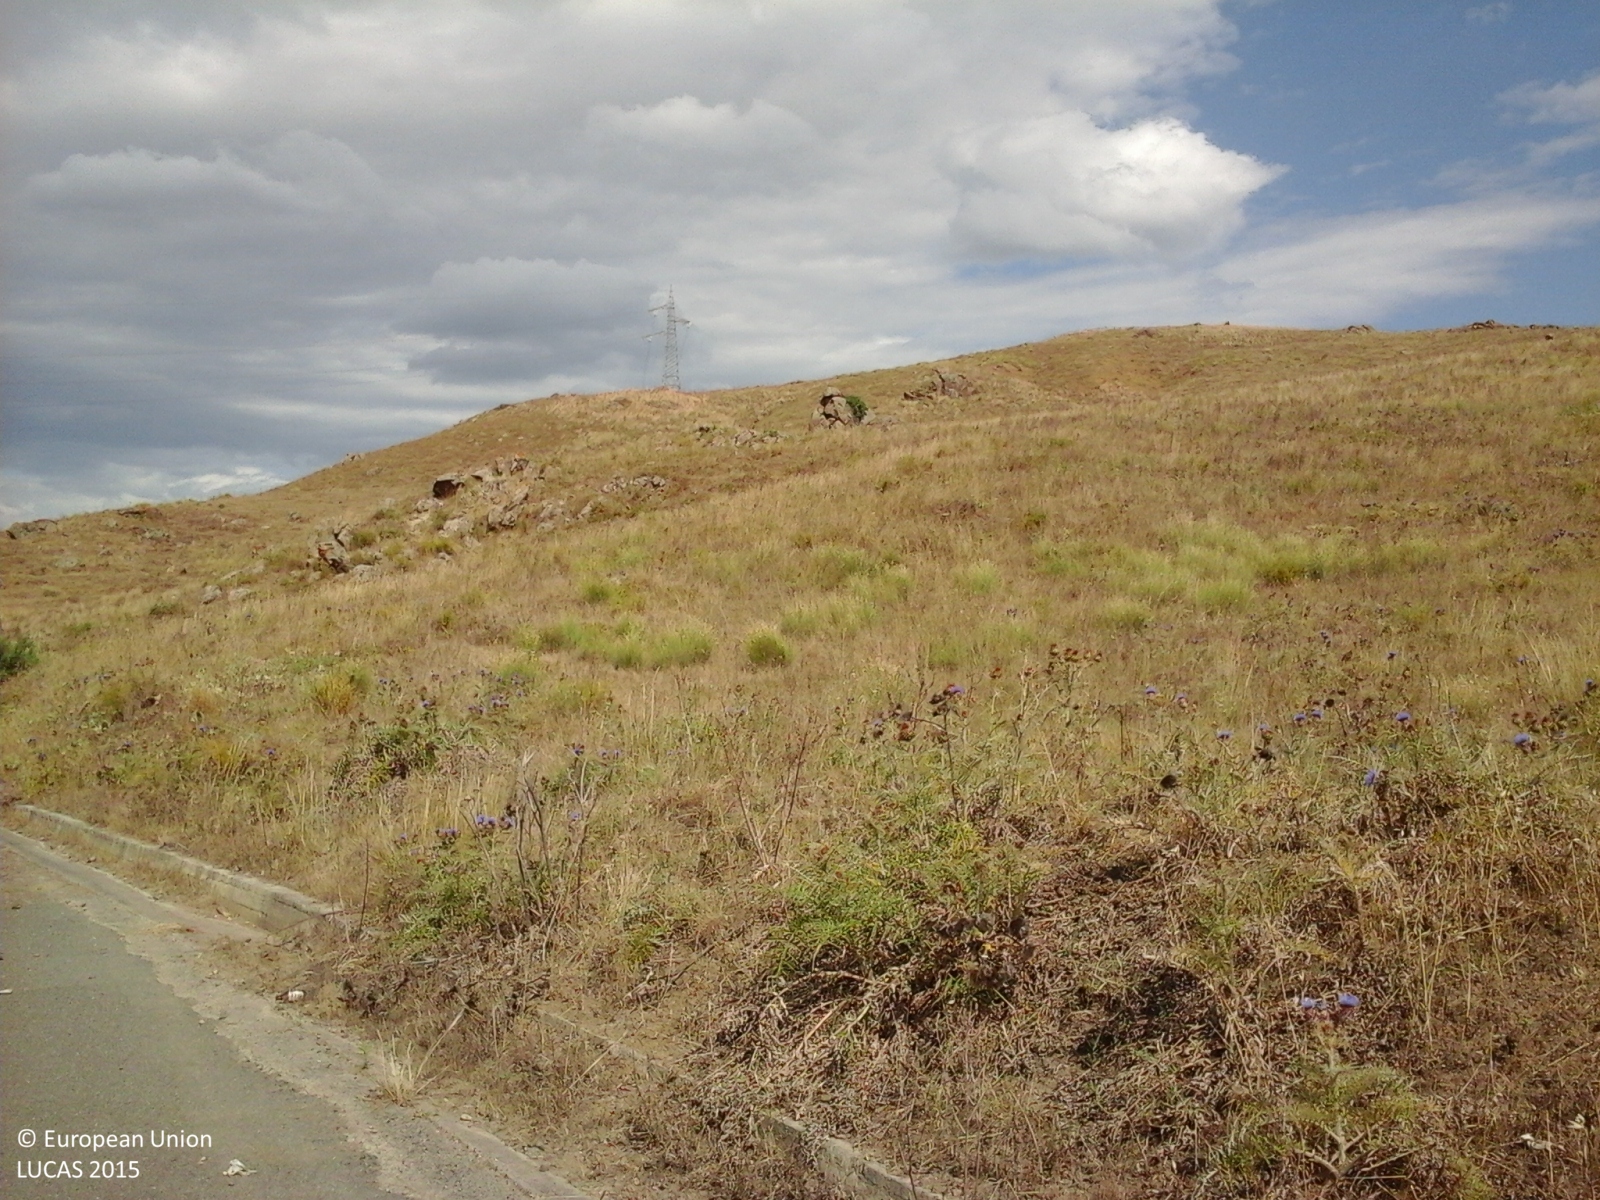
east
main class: Grassland
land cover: Grassland without tree/shrub cover
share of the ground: > 75 %
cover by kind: herbaceous plants 100 %
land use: Agriculture (excluding fallow land and kitchen gardens)
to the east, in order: Grassland without tree/shrub cover; Electric lines; Grassland without tree/shrub cover; Olive groves
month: June
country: IT
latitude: 37.5321
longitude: 14.8649
